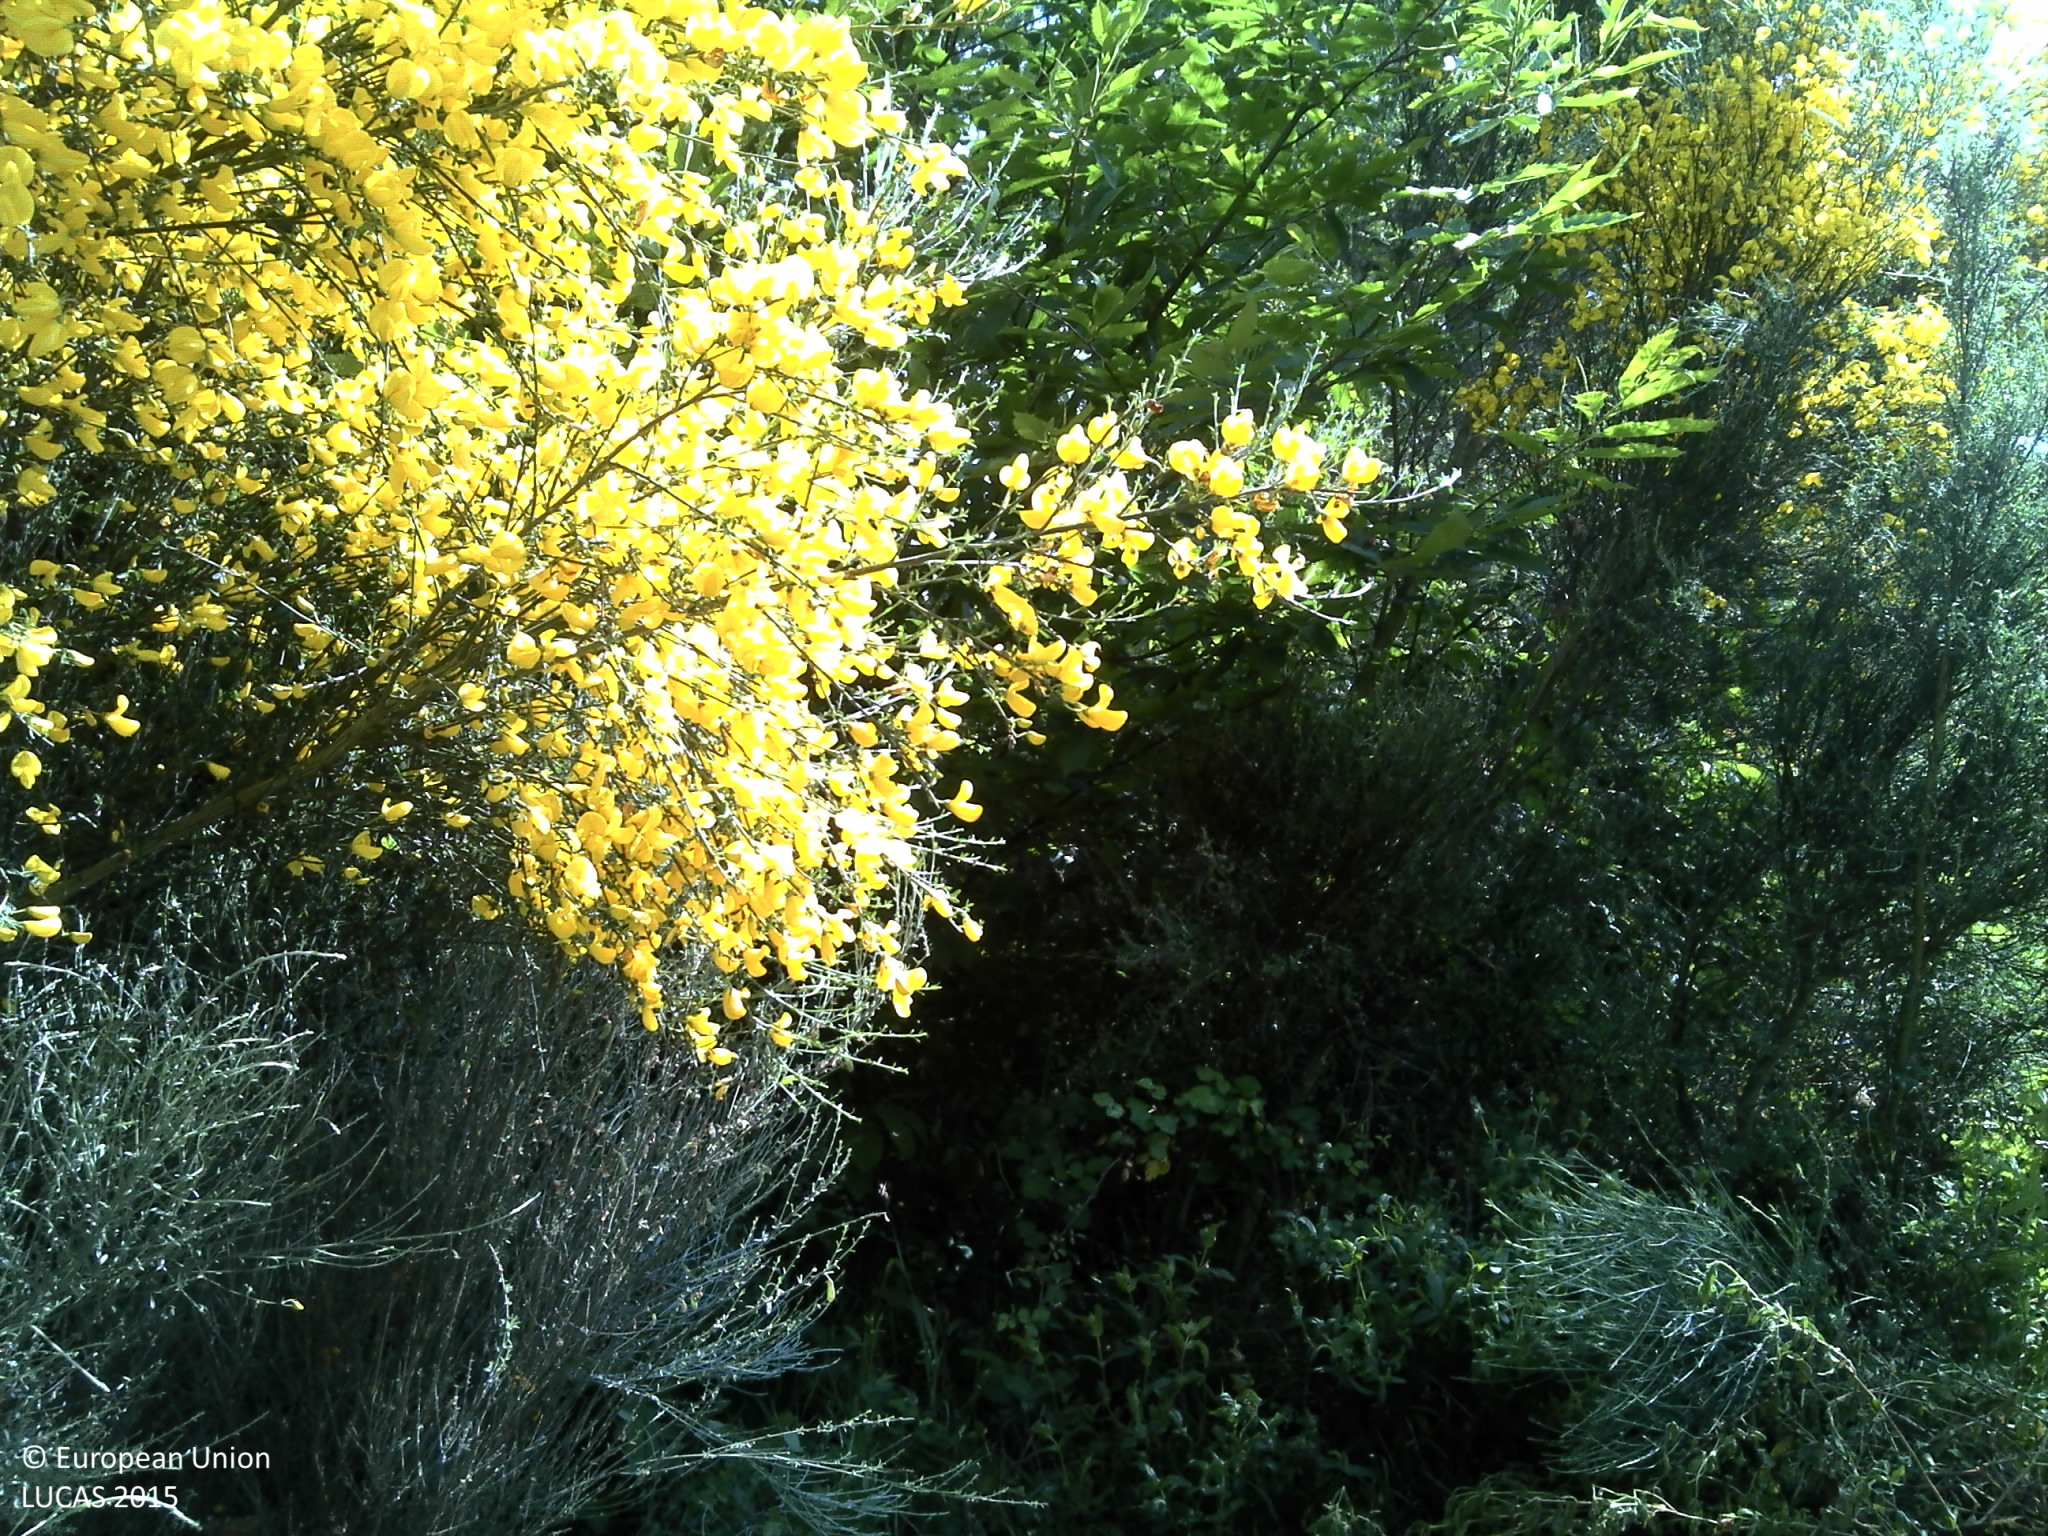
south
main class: Cropland
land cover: Nuts trees
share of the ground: 25 - 50 %
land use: Agriculture (excluding fallow land and kitchen gardens)
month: May
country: PT
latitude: 41.7145
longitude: -7.3502
